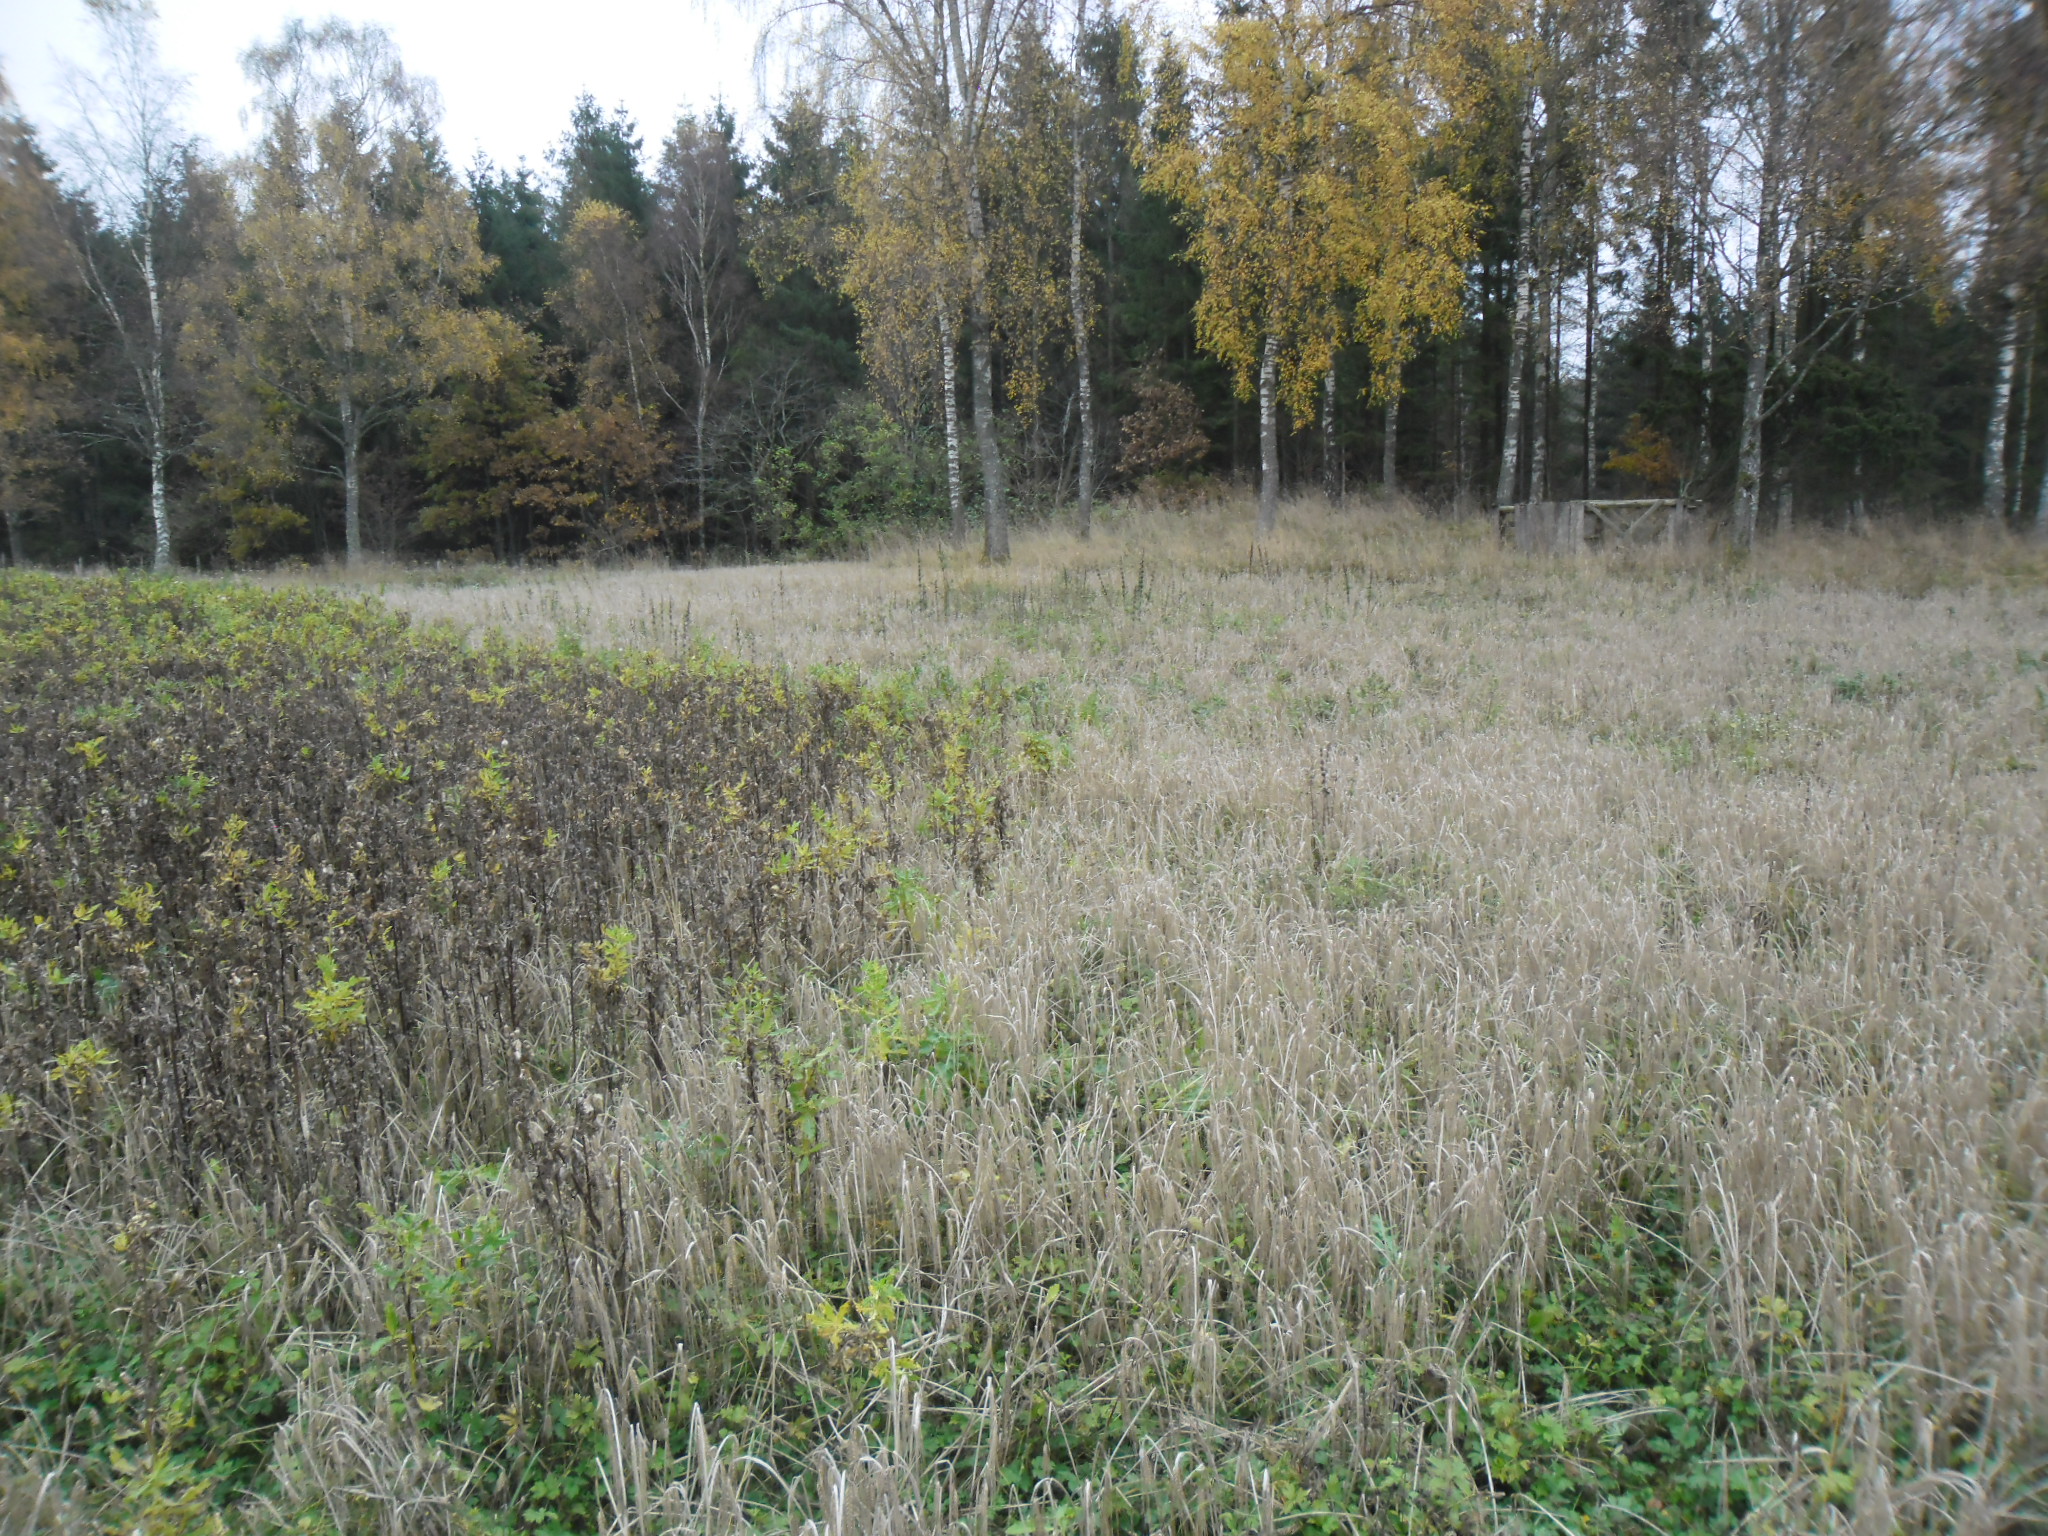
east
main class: Cropland
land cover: Barley
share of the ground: 50 - 75 %
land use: Agriculture (excluding fallow land and kitchen gardens)
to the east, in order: Barley; Broadleaved woodland; Fences; Spruce dominated coniferous woodland; Spontaneously vegetated surfaces; Spruce dominated coniferous woodland; Broadleaved woodland; Spruce dominated coniferous woodland
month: October
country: SE
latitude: 56.4368
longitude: 13.1597
